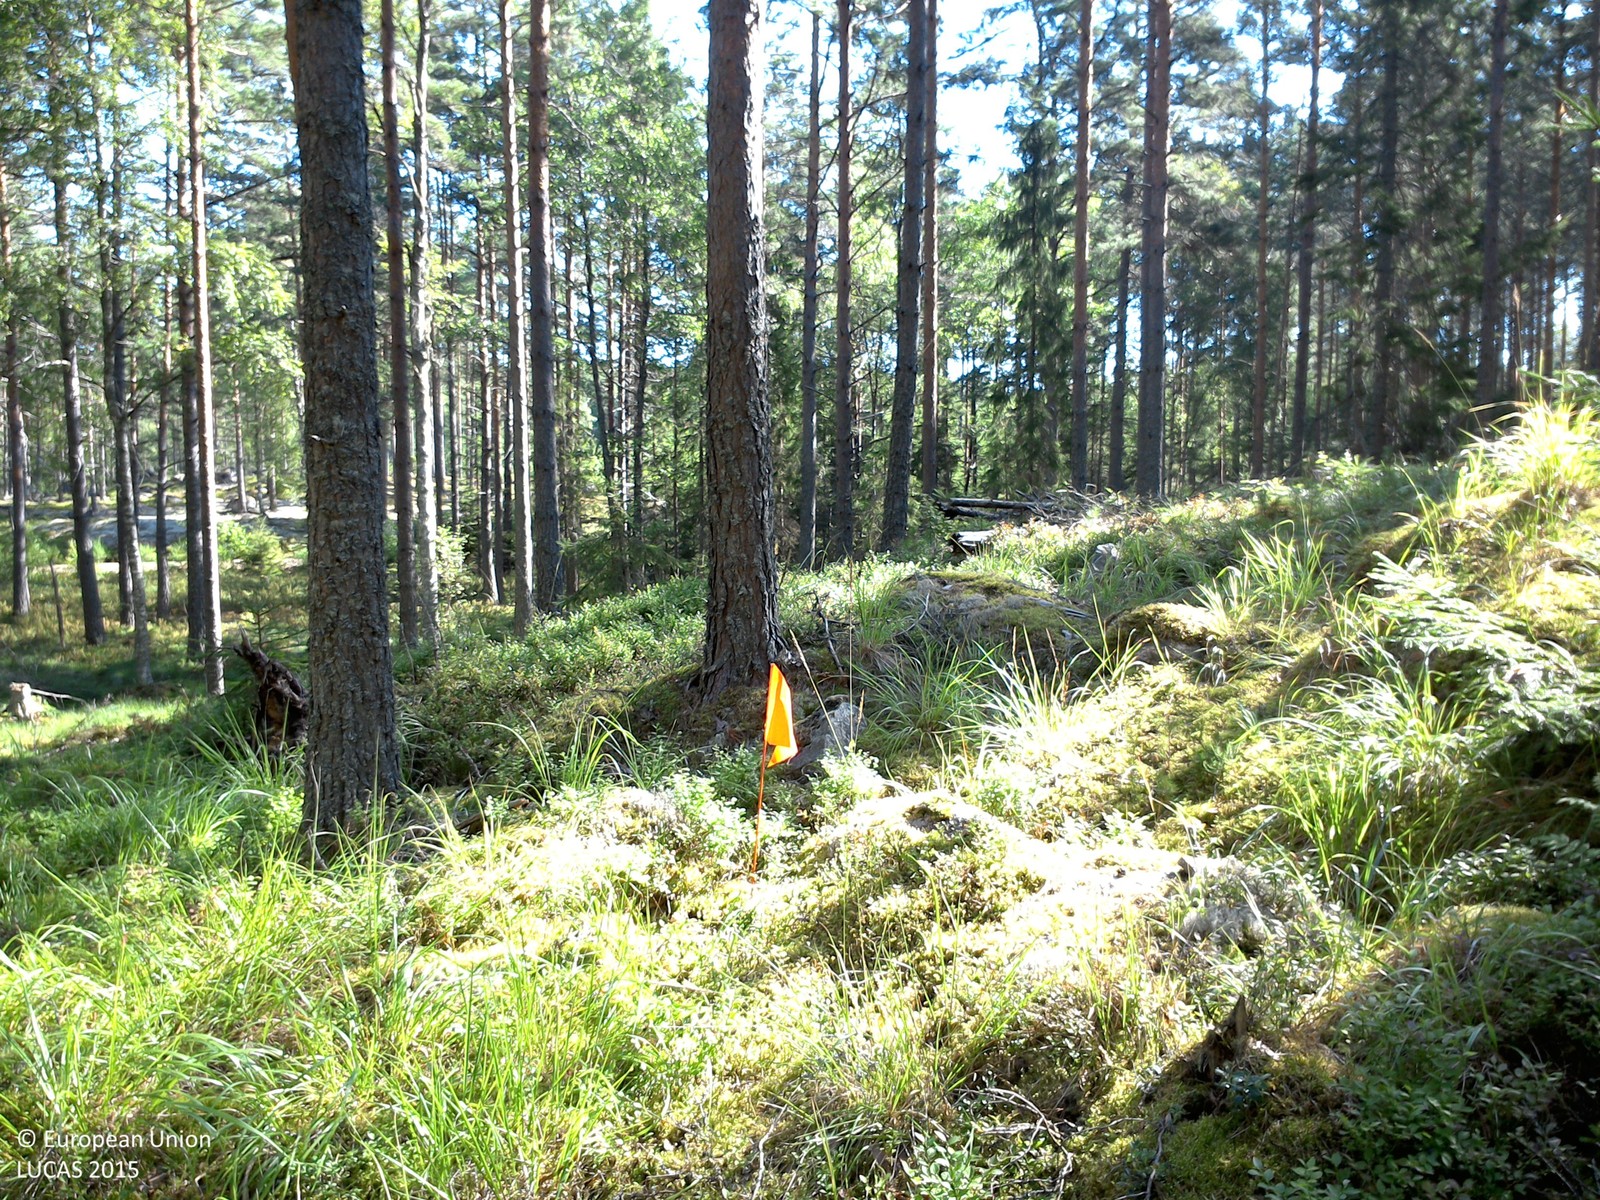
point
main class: Woodland
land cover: Pine dominated coniferous woodland
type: boreal forest
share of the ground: 50 - 75 %
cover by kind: coniferous forest trees 50 %, herbaceous plants 20 %, lichens and mosses 20 %, shrubs 10 %
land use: Forestry
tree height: > 5 m
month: August
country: SE
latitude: 57.8550
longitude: 15.9114
